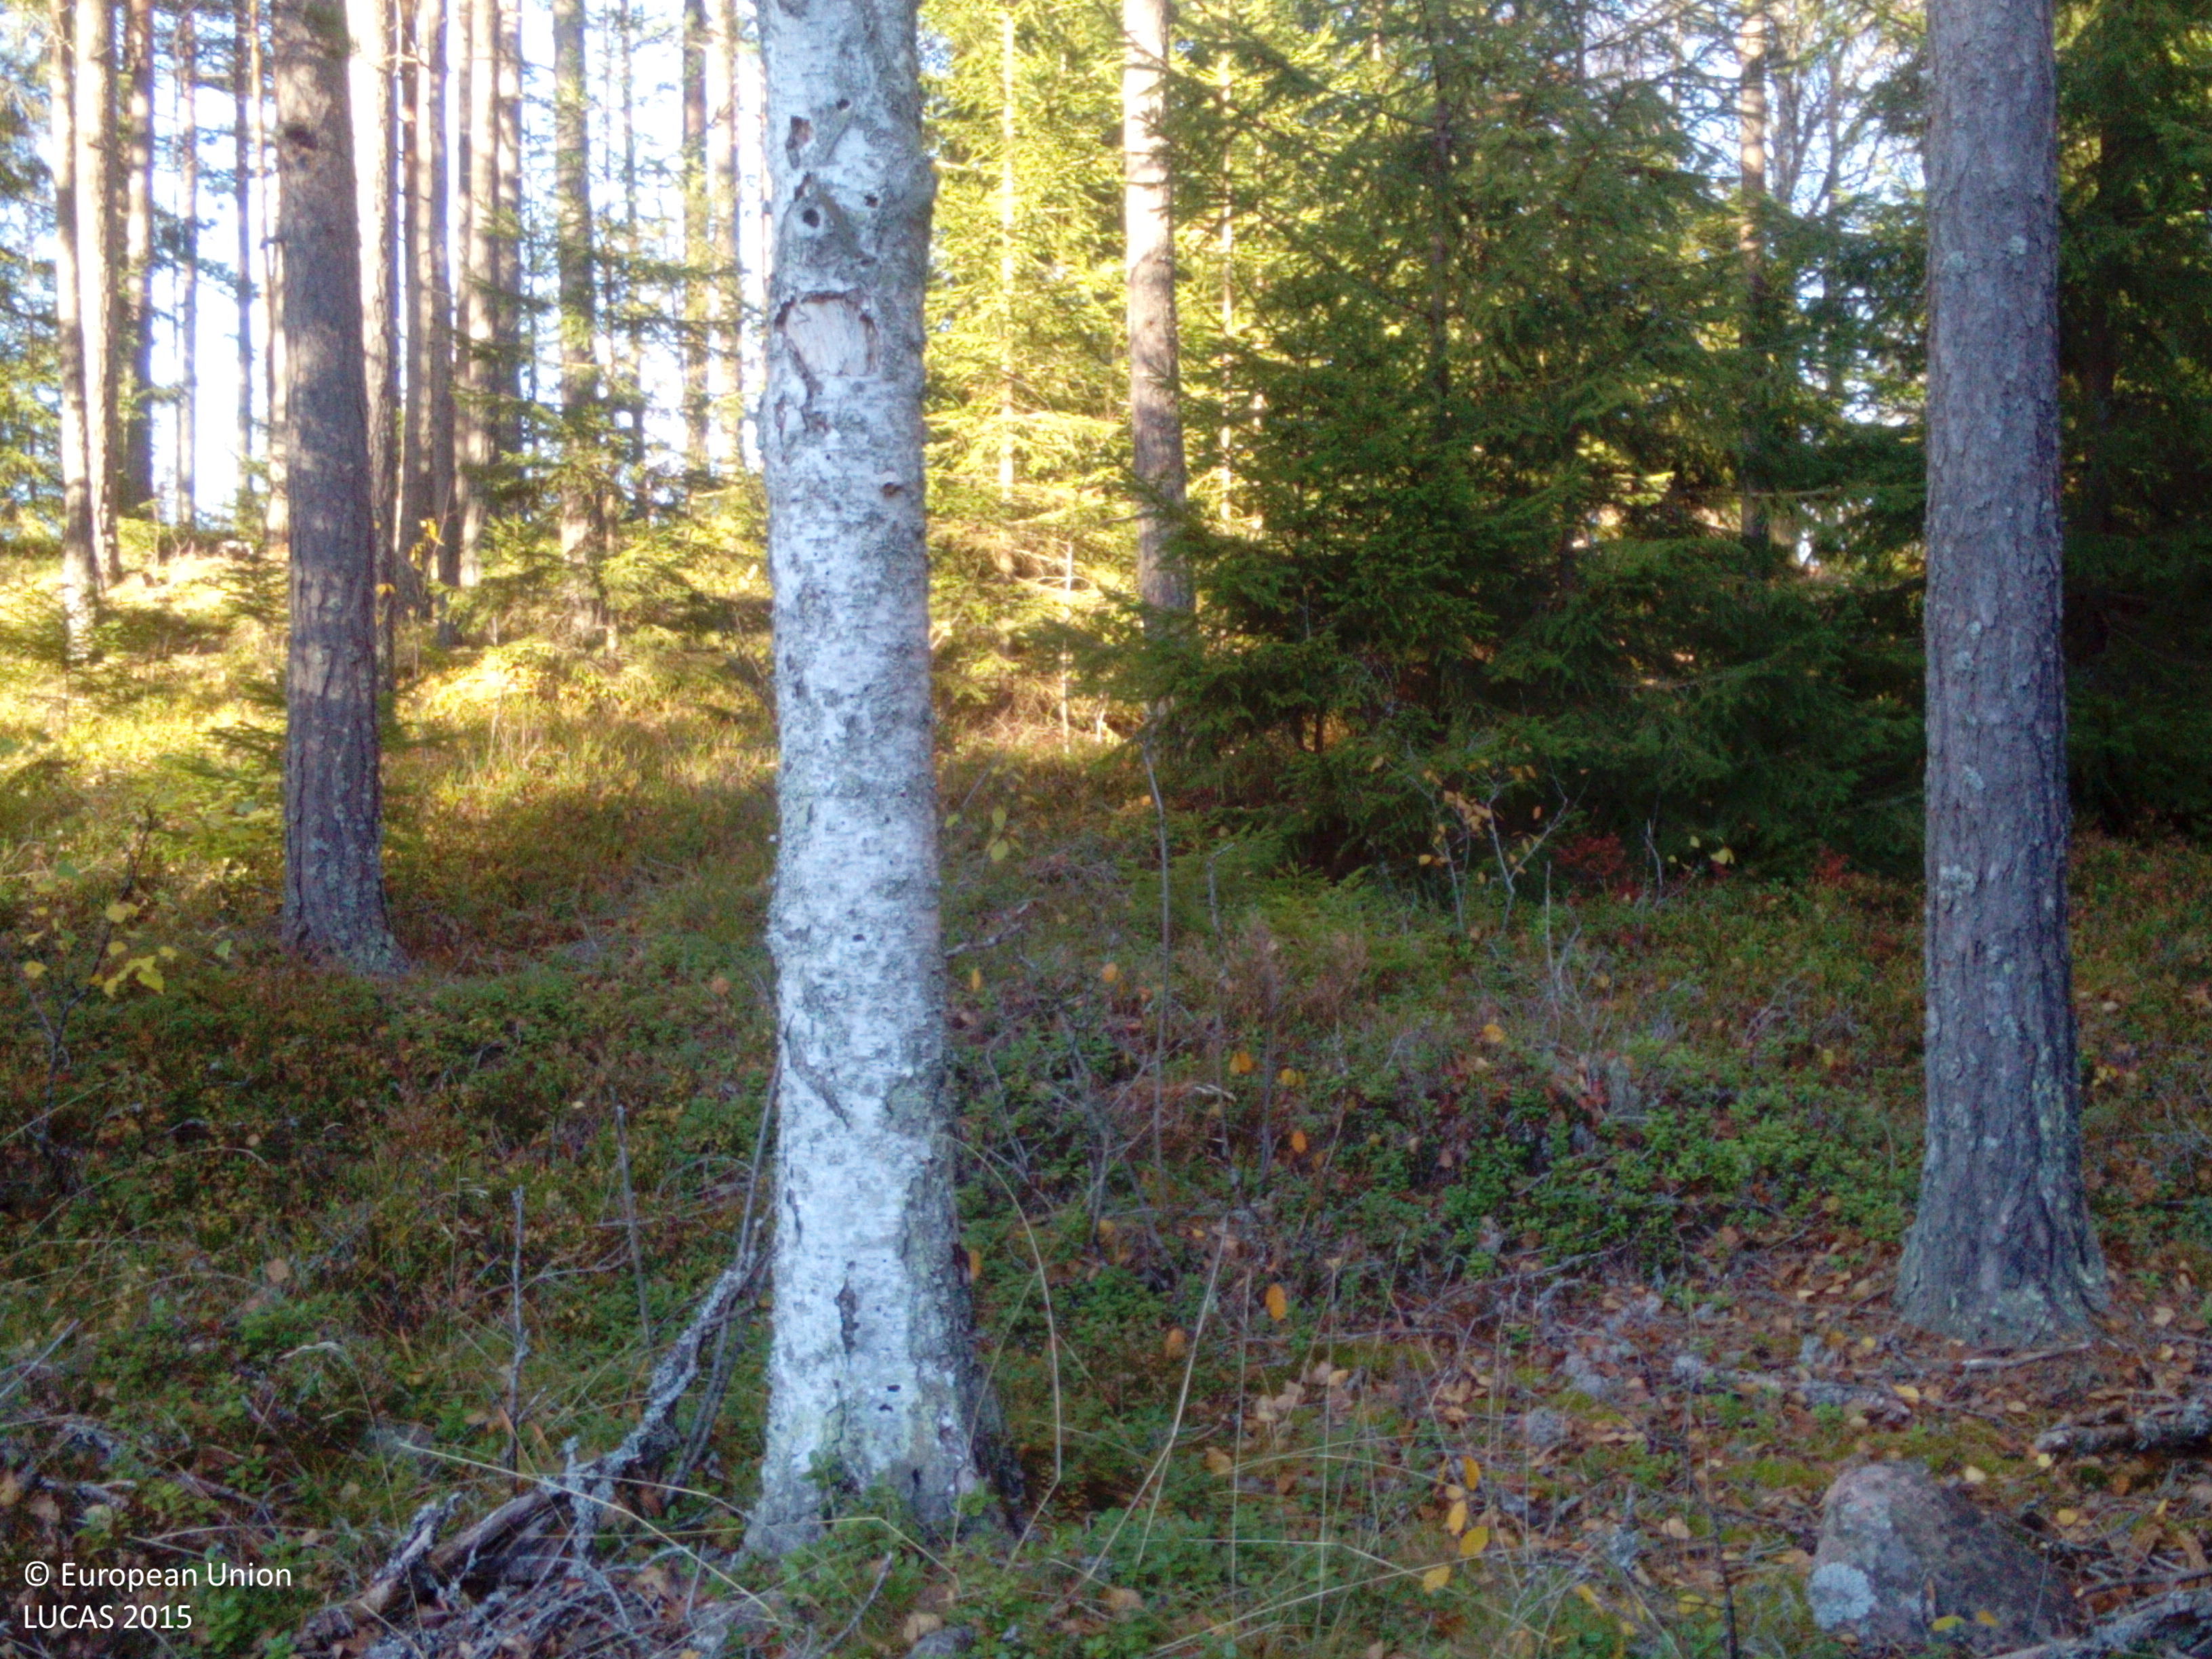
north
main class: Woodland
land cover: Pine dominated coniferous woodland
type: boreal forest
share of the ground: 25 - 50 %
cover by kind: herbaceous plants 55 %, coniferous forest trees 40 %, broadleaved forest trees 5 %
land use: Forestry
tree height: > 5 m
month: October
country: SE
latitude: 59.1303
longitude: 16.4415
